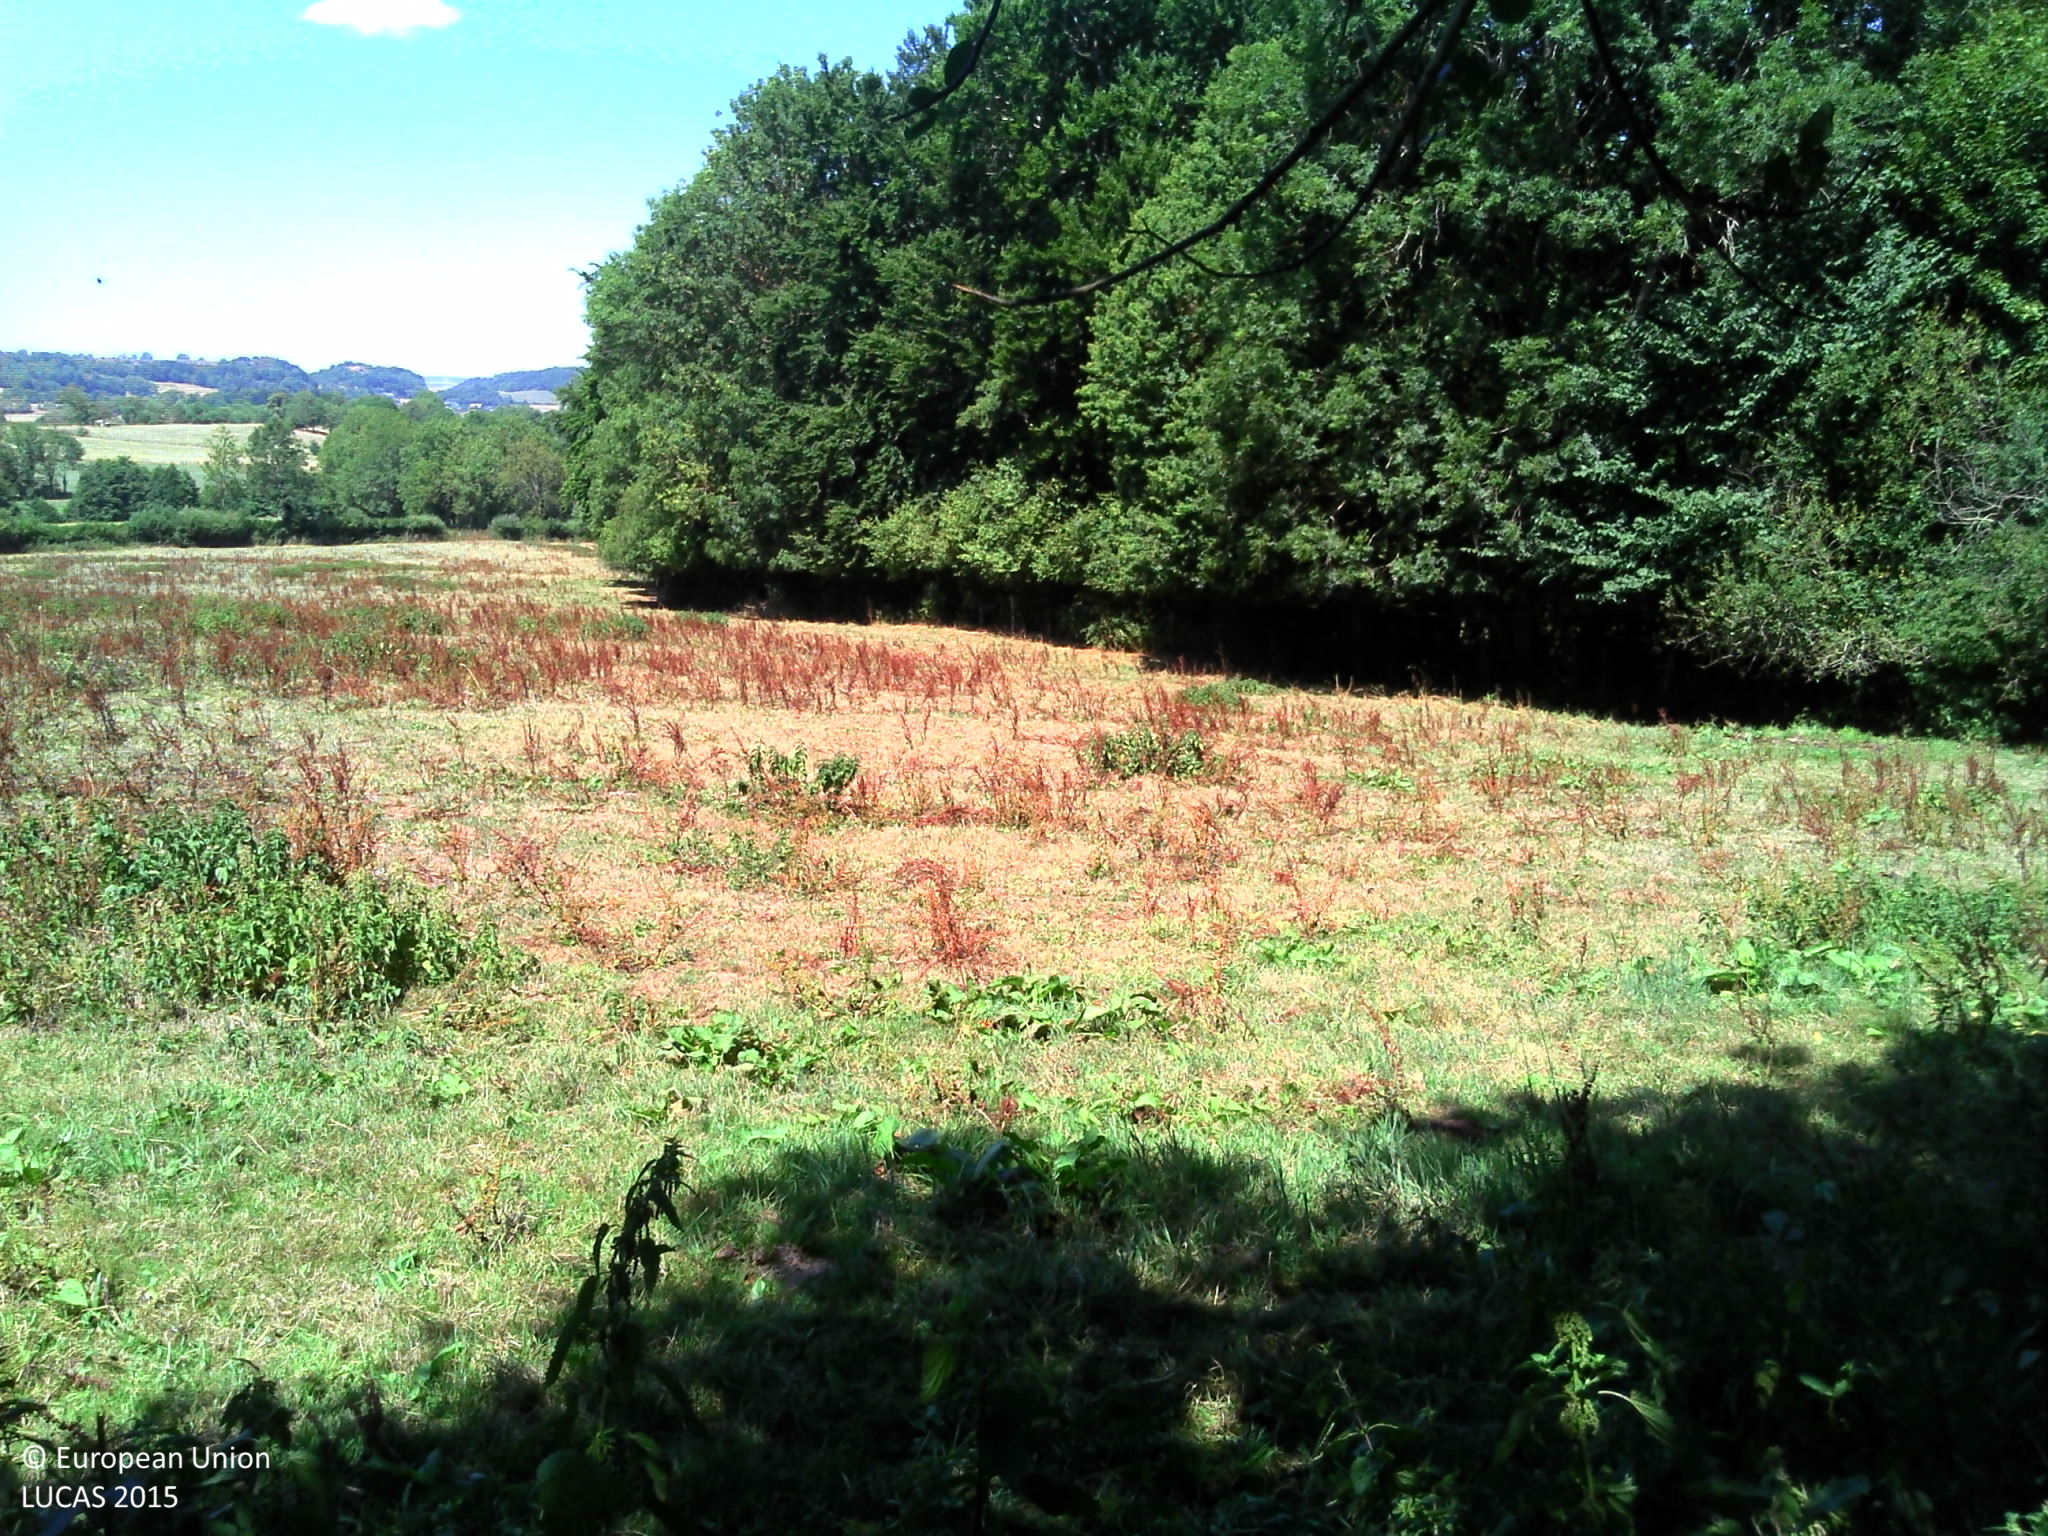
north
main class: Woodland
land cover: Broadleaved woodland
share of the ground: > 75 %
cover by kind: herbaceous plants 80 %, broadleaved forest trees 20 %
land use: Agriculture (excluding fallow land and kitchen gardens)
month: August
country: FR
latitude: 45.6794
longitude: 2.8739
